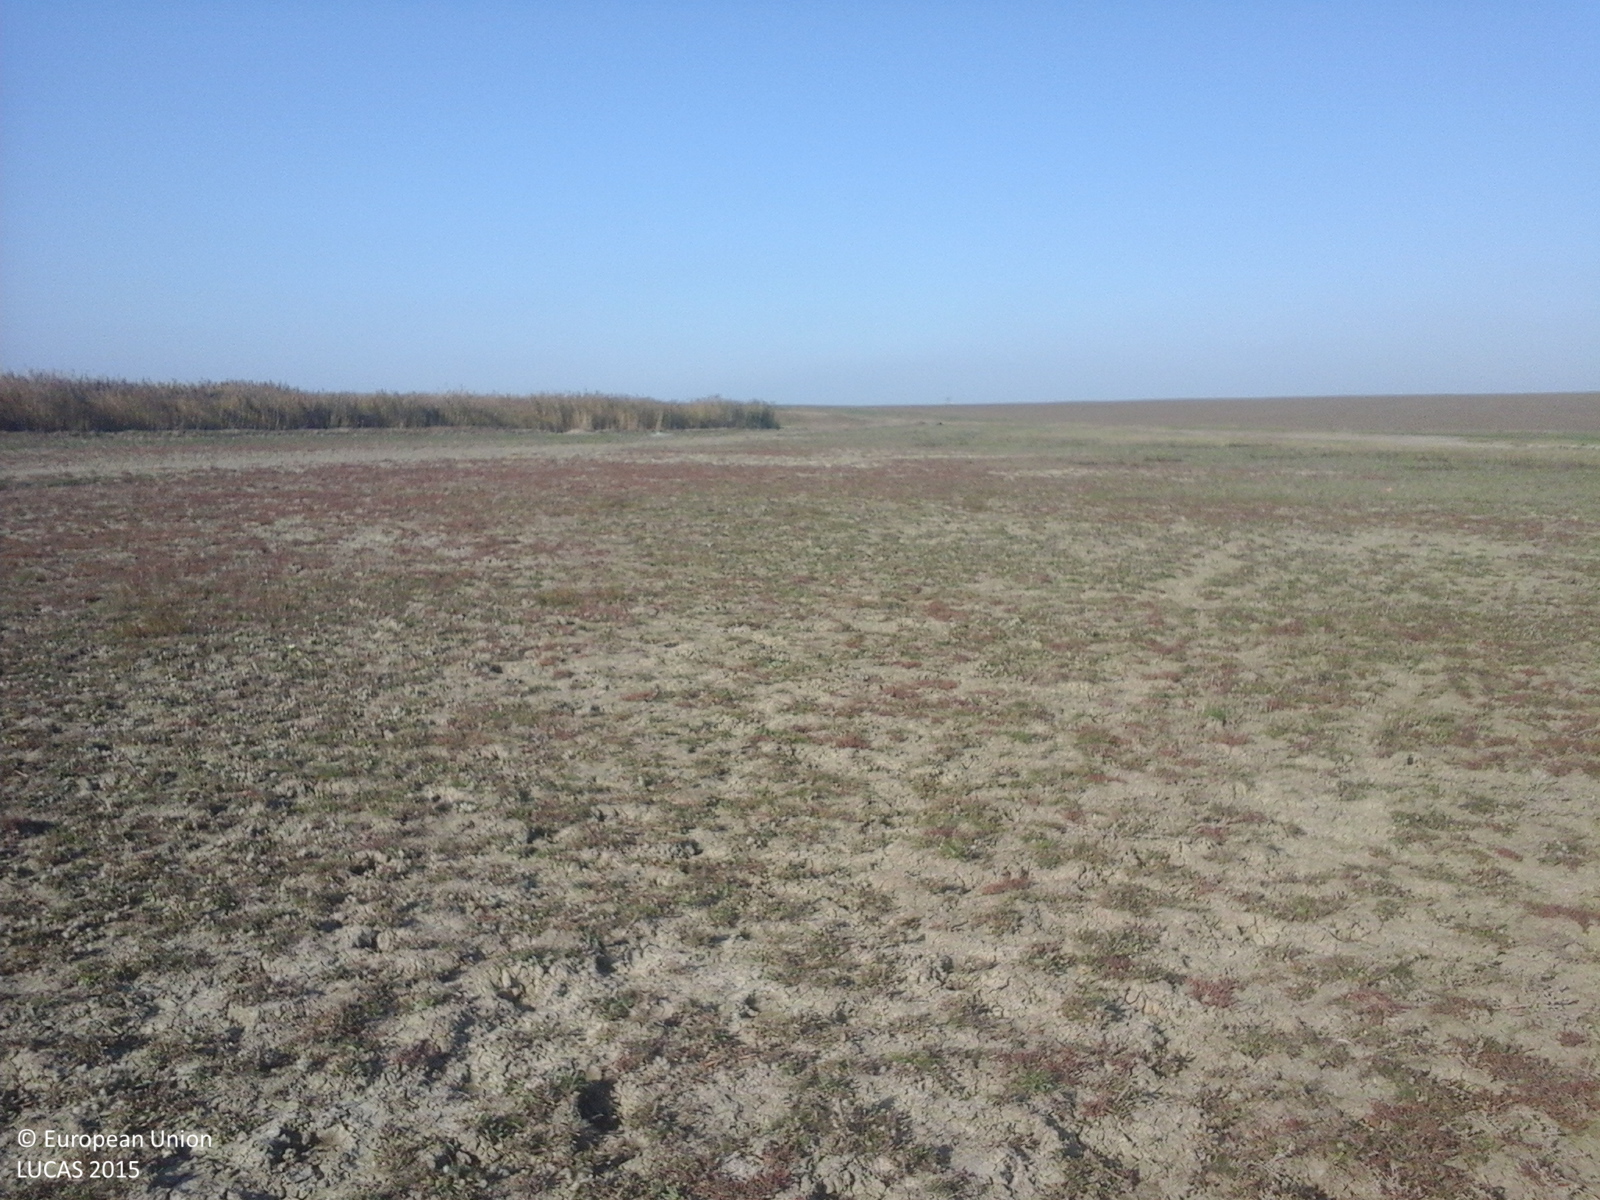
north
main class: Grassland
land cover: Grassland without tree/shrub cover
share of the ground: > 75 %
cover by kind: herbaceous plants 100 %
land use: Agriculture (excluding fallow land and kitchen gardens)
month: October
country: RO
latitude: 45.2181
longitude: 27.3241
